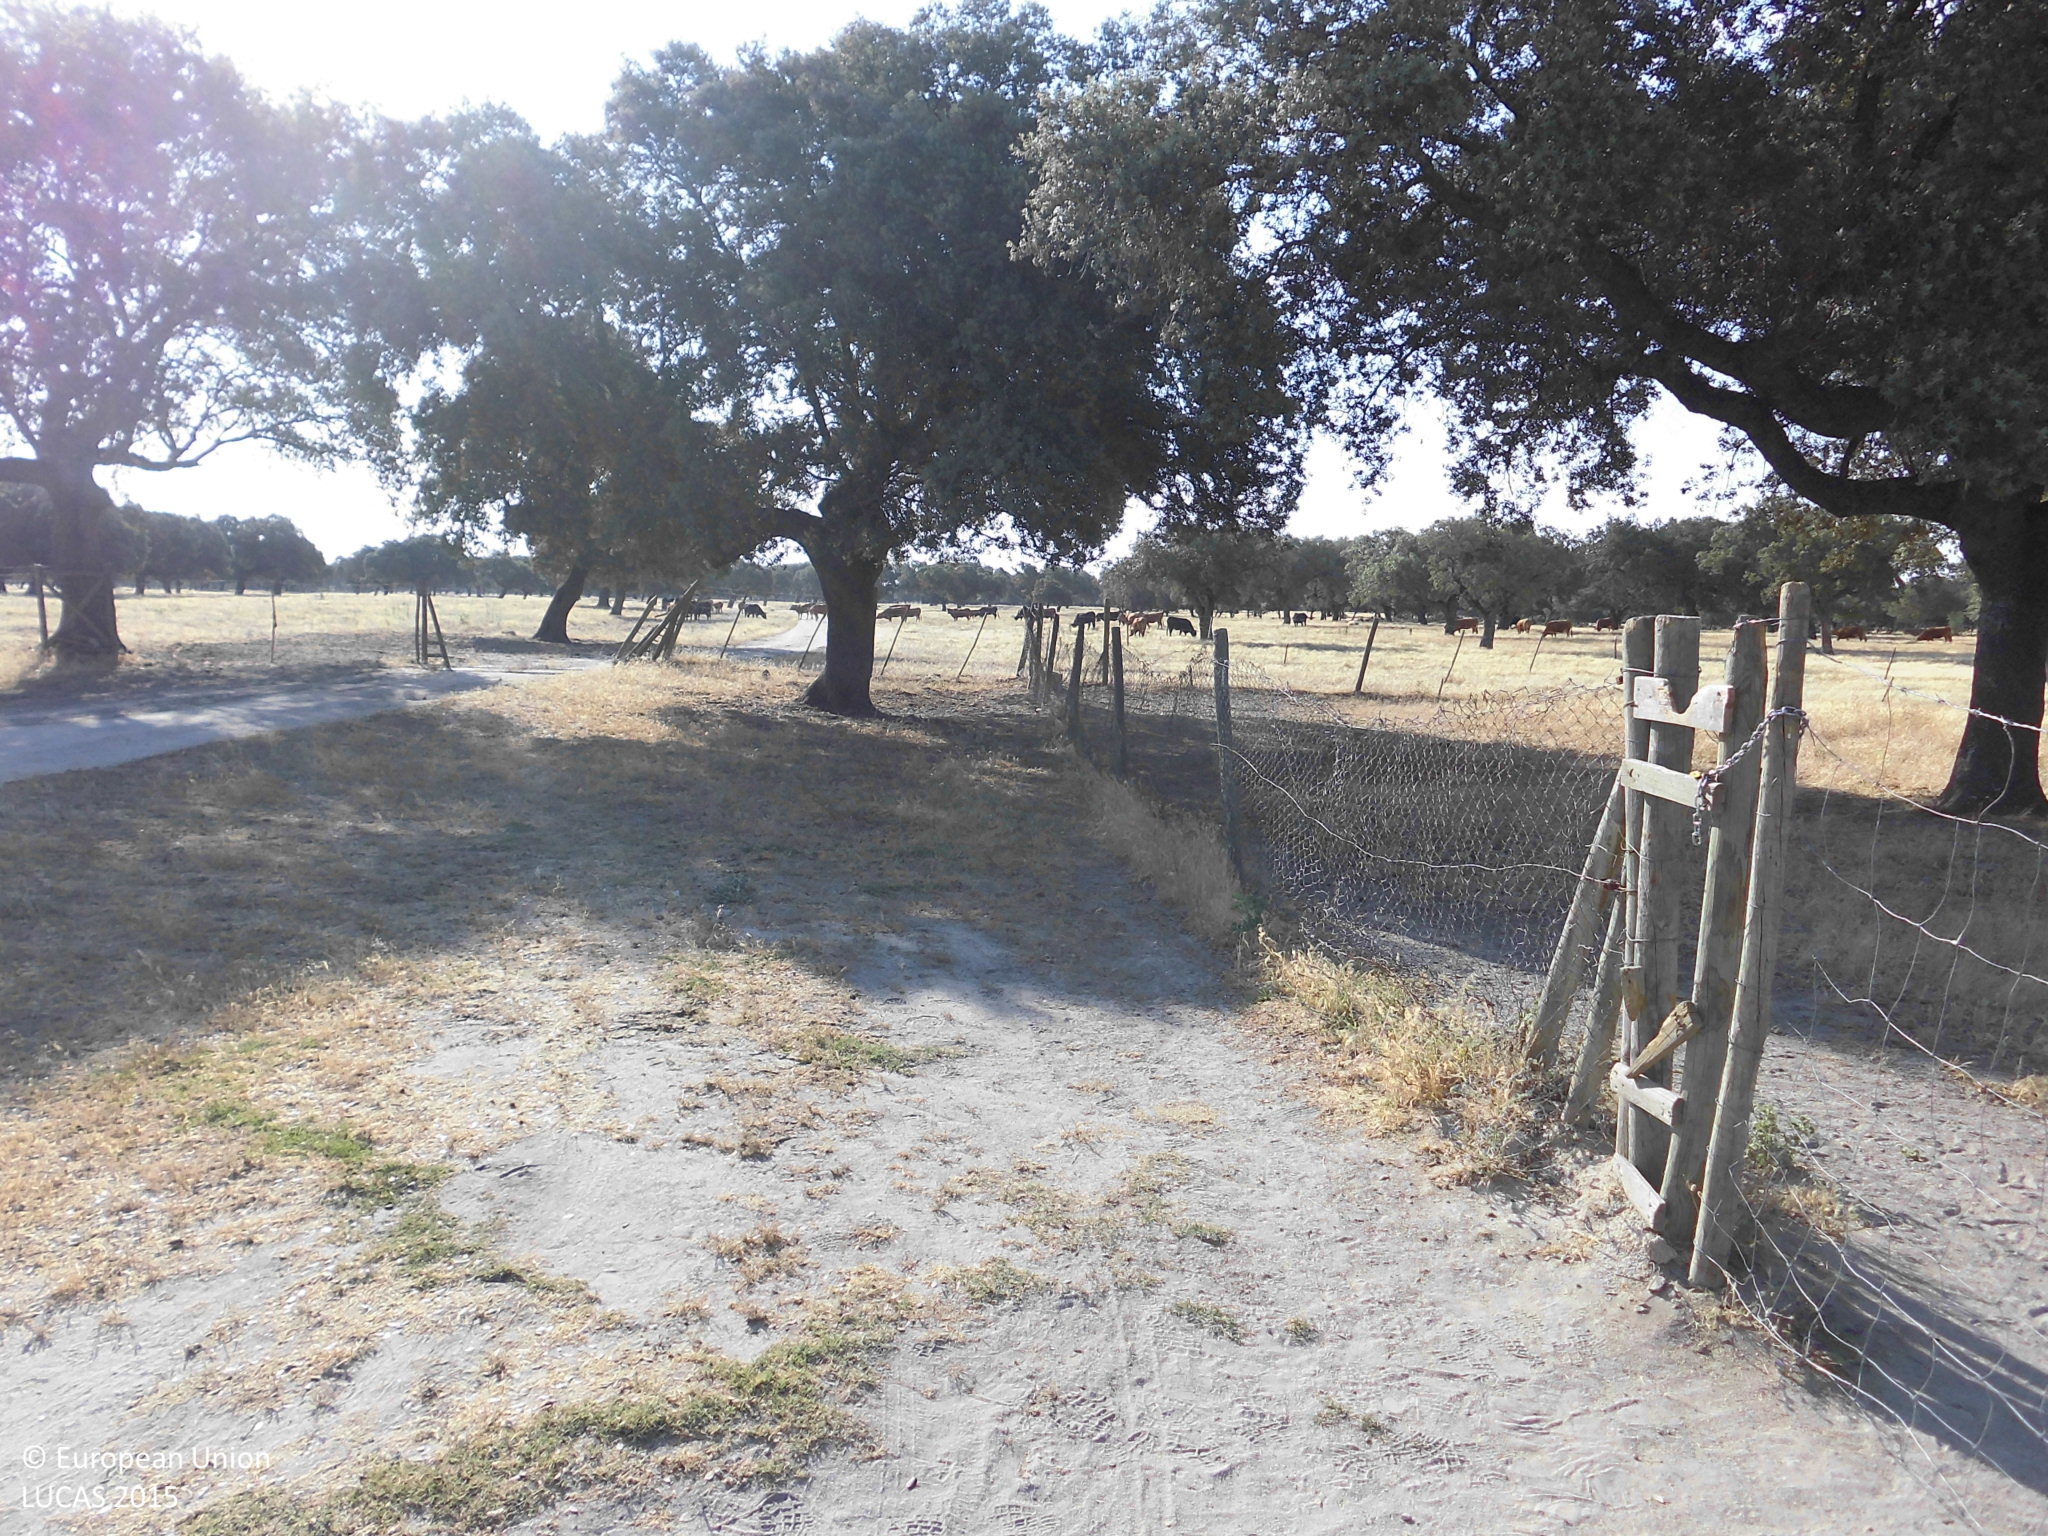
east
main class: Woodland
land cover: Broadleaved woodland
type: broadleaved evergreen forest
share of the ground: 25 - 50 %
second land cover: Grassland without tree/shrub cover
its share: > 75 %
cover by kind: herbaceous plants 70 %, broadleaved forest trees 30 %
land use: Forestry
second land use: Agriculture (excluding fallow land and kitchen gardens)
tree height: > 5 m
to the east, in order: Broadleaved woodland; Grassland without tree/shrub cover; Tracks; Broadleaved woodland; Rivers and streams; Broadleaved woodland
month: June
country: ES
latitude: 39.9578
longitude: -5.4279
